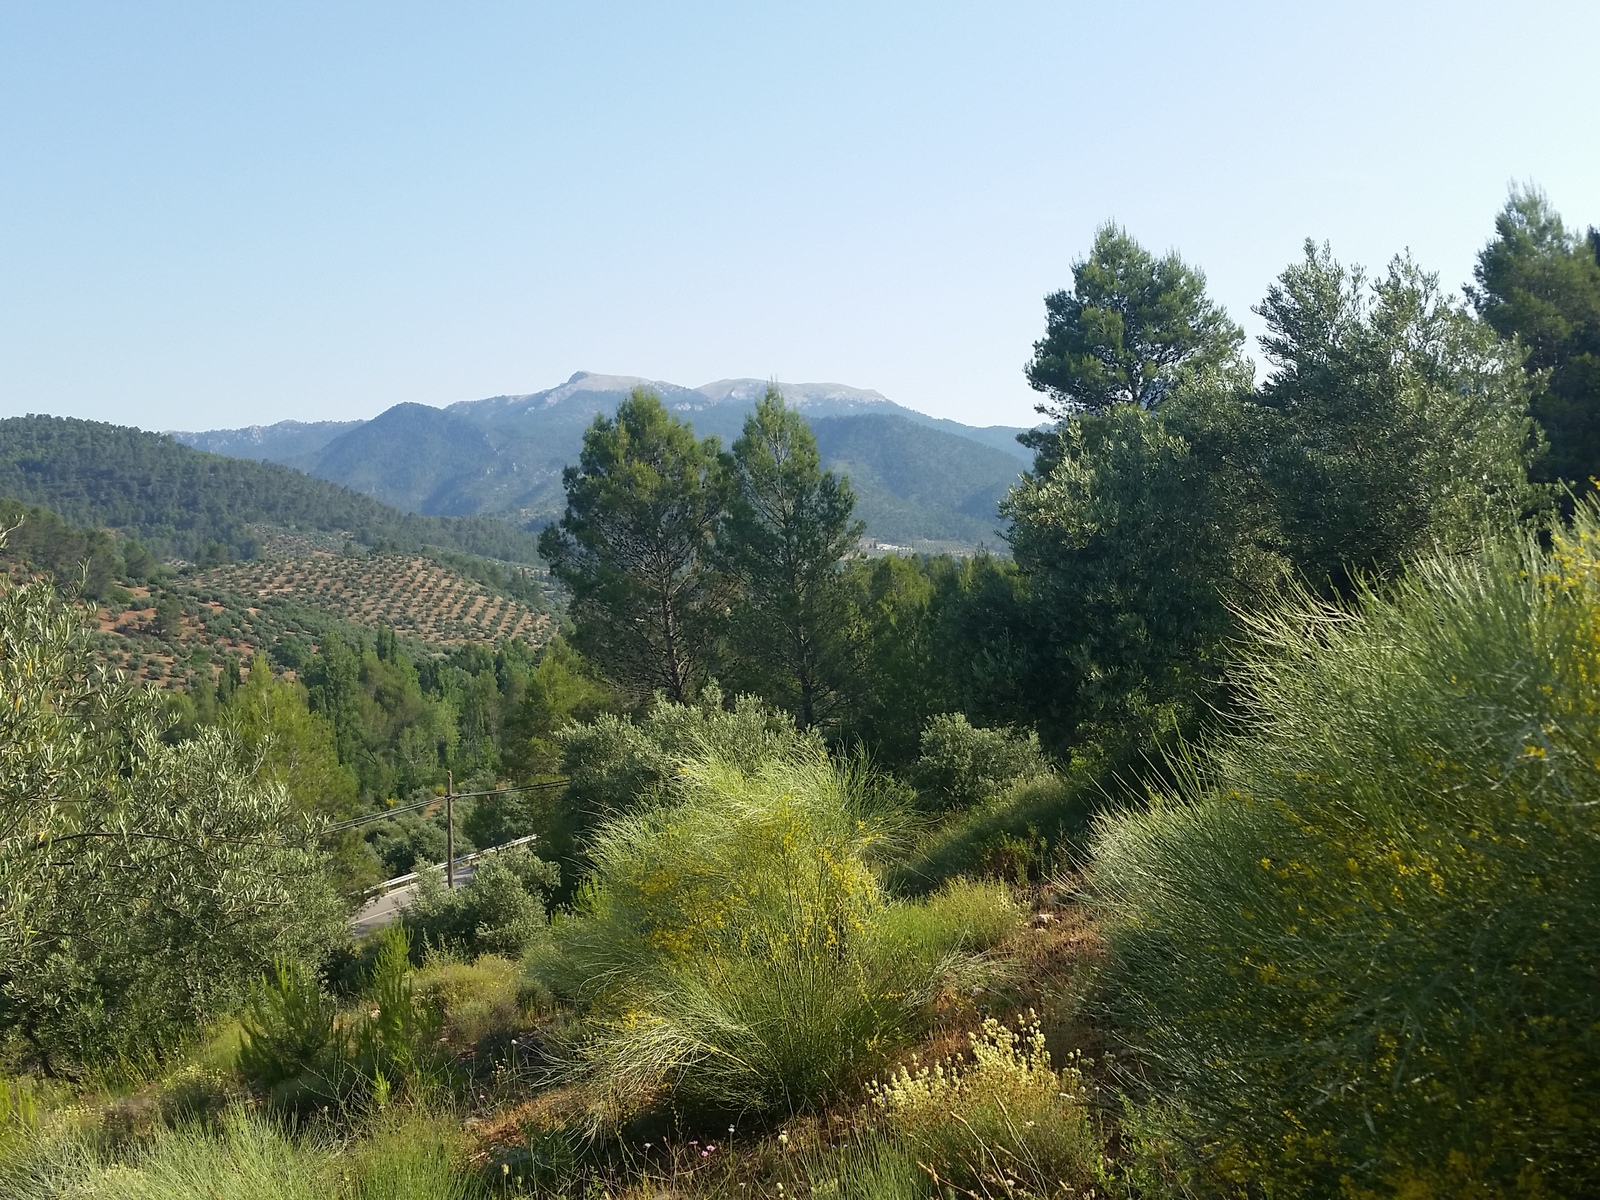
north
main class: Cropland
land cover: Olive groves
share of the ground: 25 - 50 %
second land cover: Grassland without tree/shrub cover
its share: 10 - 25 %
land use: Agriculture (excluding fallow land and kitchen gardens)
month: June
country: ES
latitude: 38.4372
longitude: -2.5202
